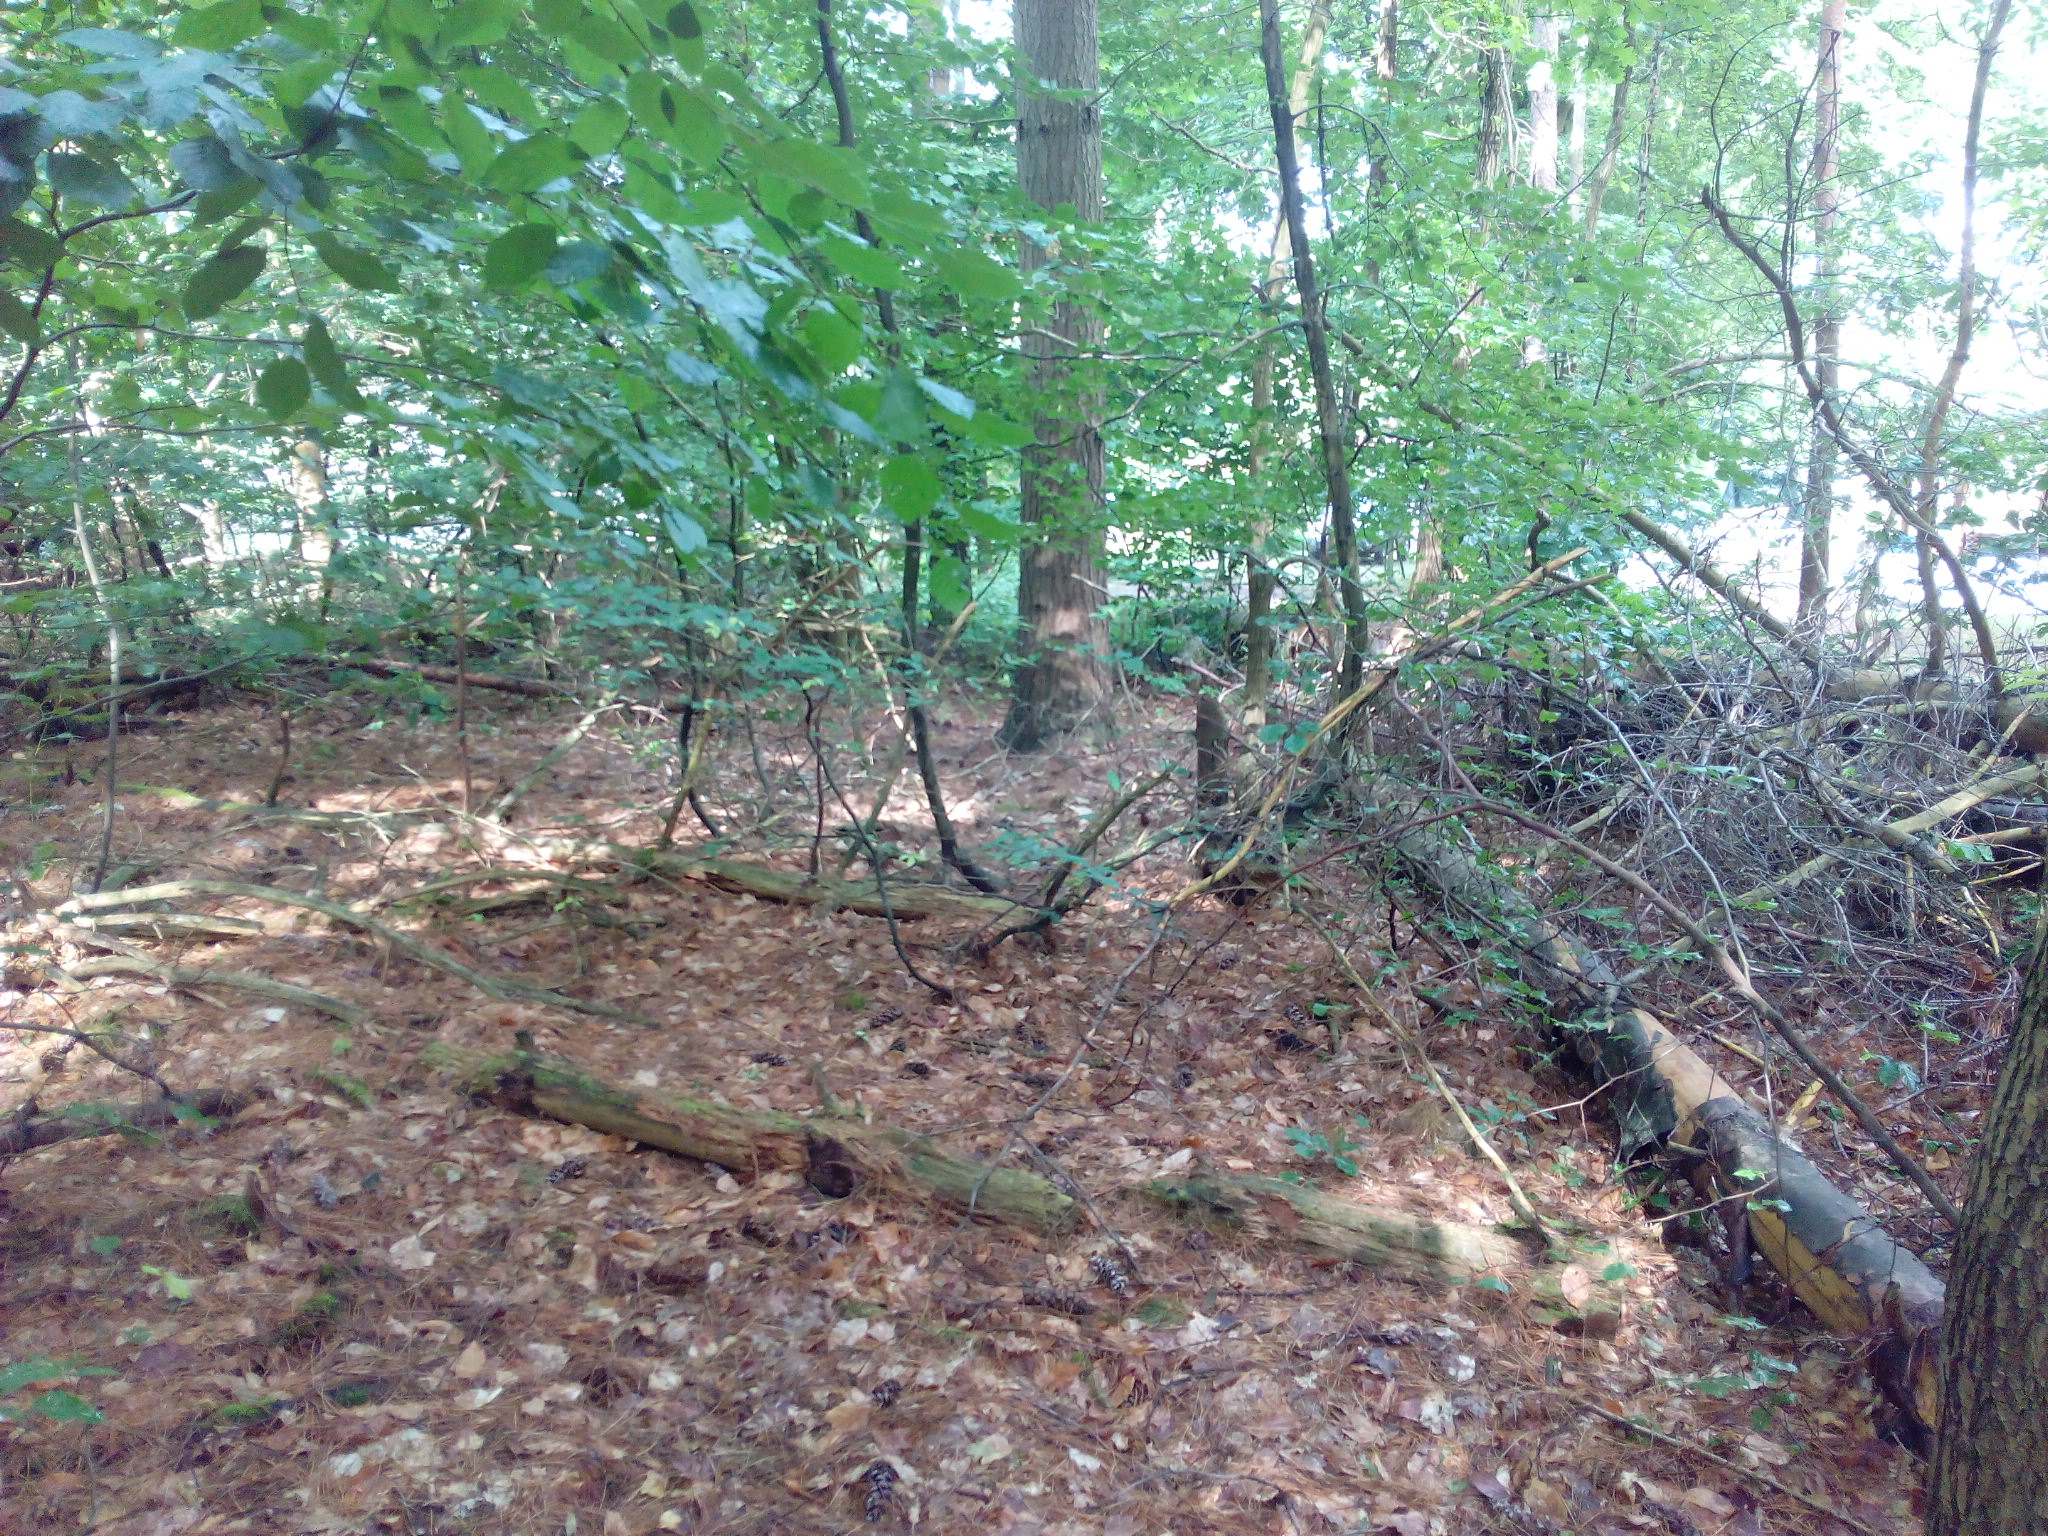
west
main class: Woodland
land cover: Pine dominated mixed woodland
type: hemiboreal forest and nemoral coniferous forest and mixed broadleaved-coniferous forest
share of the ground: > 75 %
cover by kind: coniferous forest trees 60 %, broadleaved forest trees 25 %, unconsolidated bare surface 10 %, shrubs 5 %
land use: Forestry
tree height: > 5 m
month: June
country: DE
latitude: 53.2699
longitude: 13.1935
